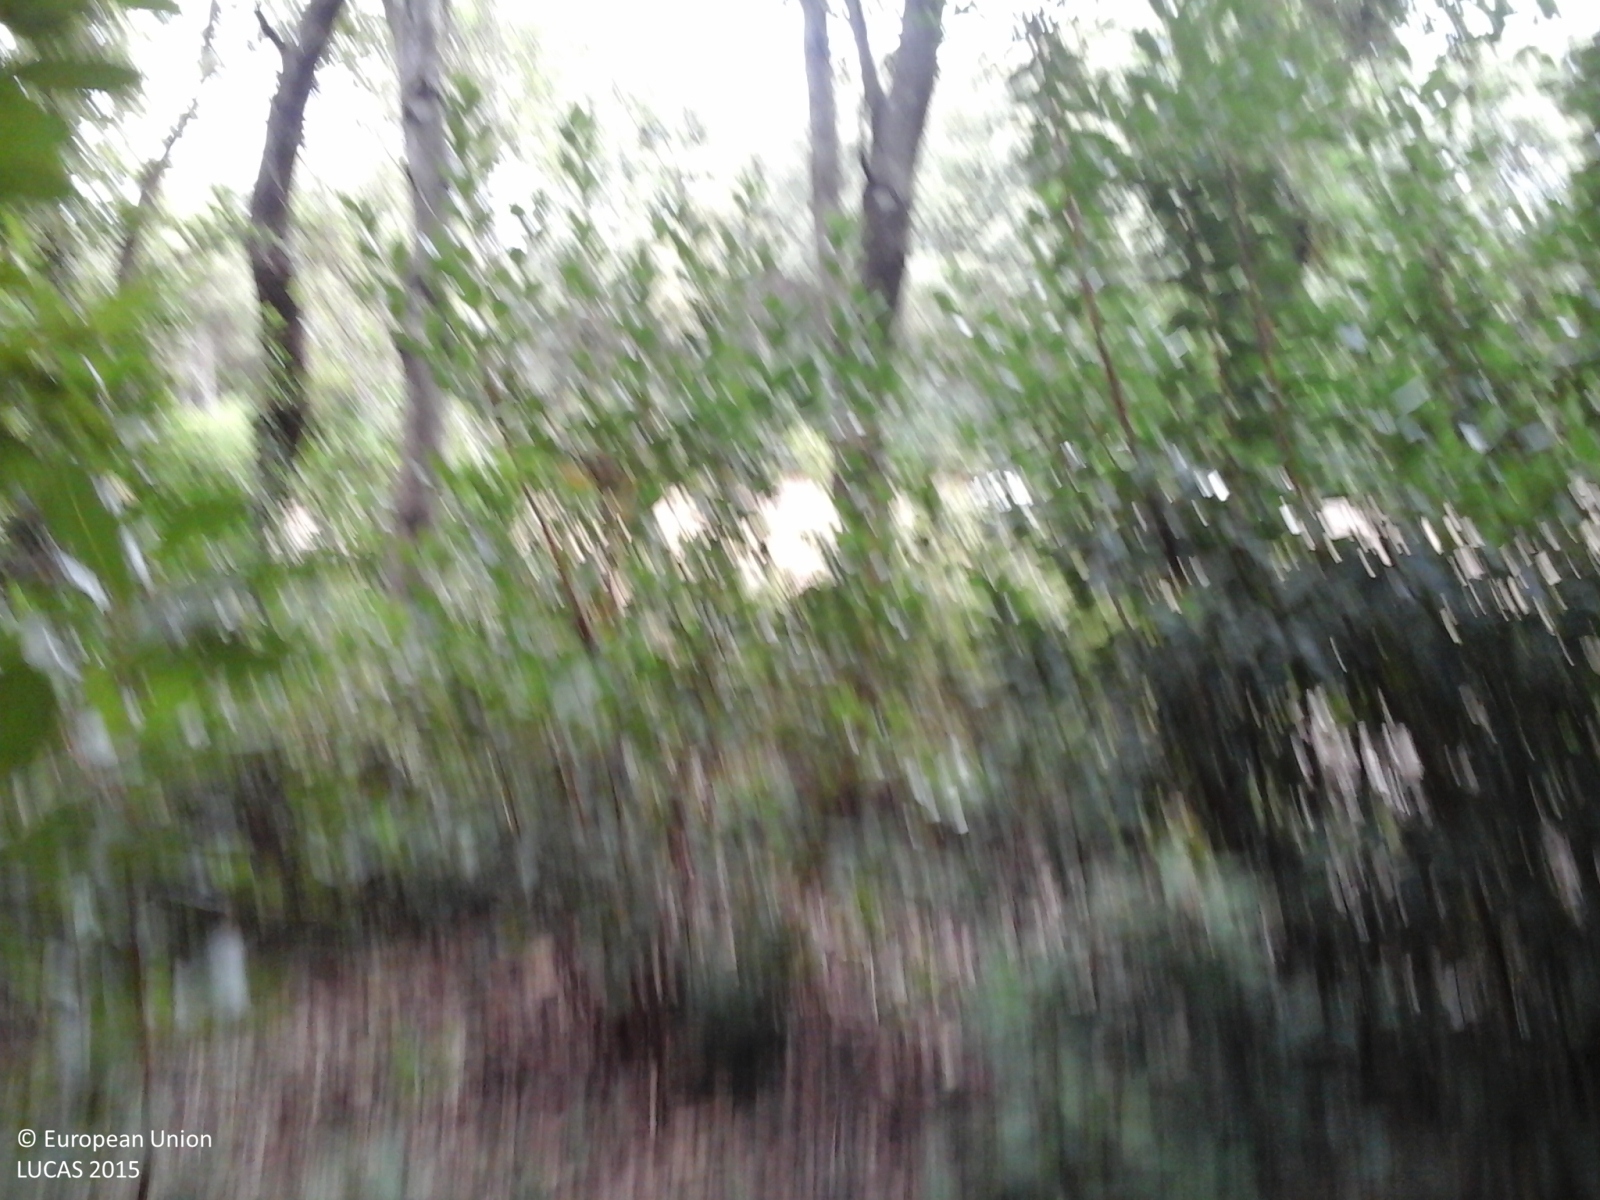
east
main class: Woodland
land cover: Broadleaved woodland
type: broadleaved evergreen forest
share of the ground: > 75 %
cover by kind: broadleaved forest trees 100 %
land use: Semi-natural and natural areas not in use
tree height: < 5 m
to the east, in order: Broadleaved woodland; Other structural elements; Broadleaved woodland
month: July
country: IT
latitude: 39.8287
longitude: 9.1054
